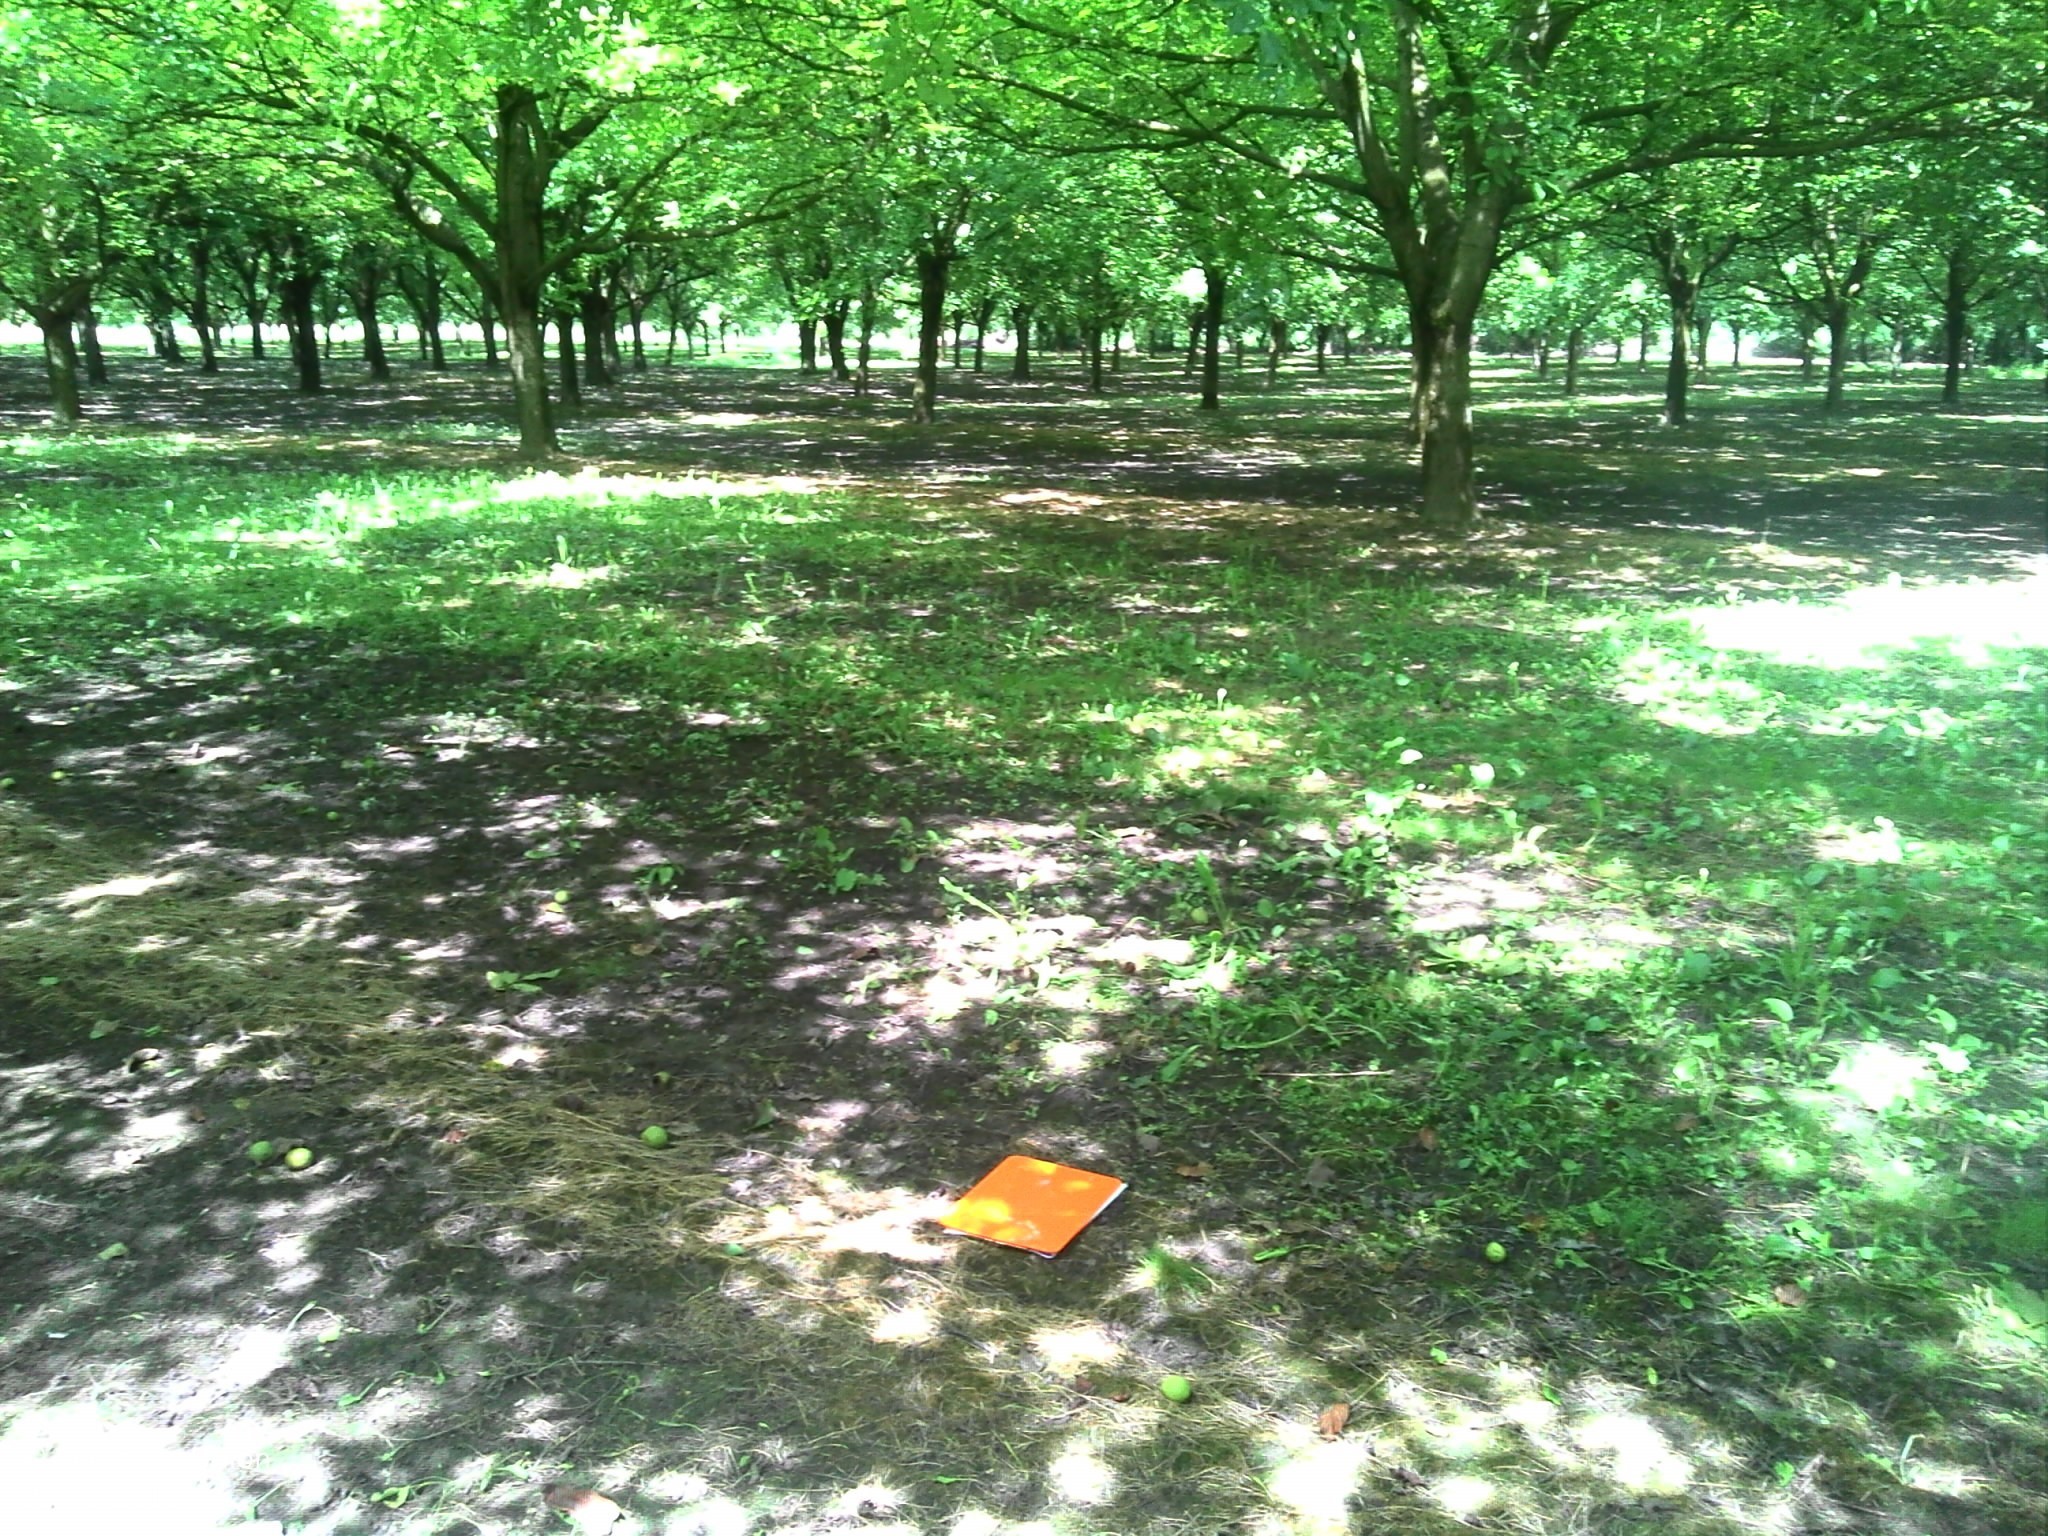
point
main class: Cropland
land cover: Nuts trees
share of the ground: > 75 %
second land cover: Spontaneously vegetated surfaces
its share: 25 - 50 %
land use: Agriculture (excluding fallow land and kitchen gardens)
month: August
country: FR
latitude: 45.2273
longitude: 5.4839
